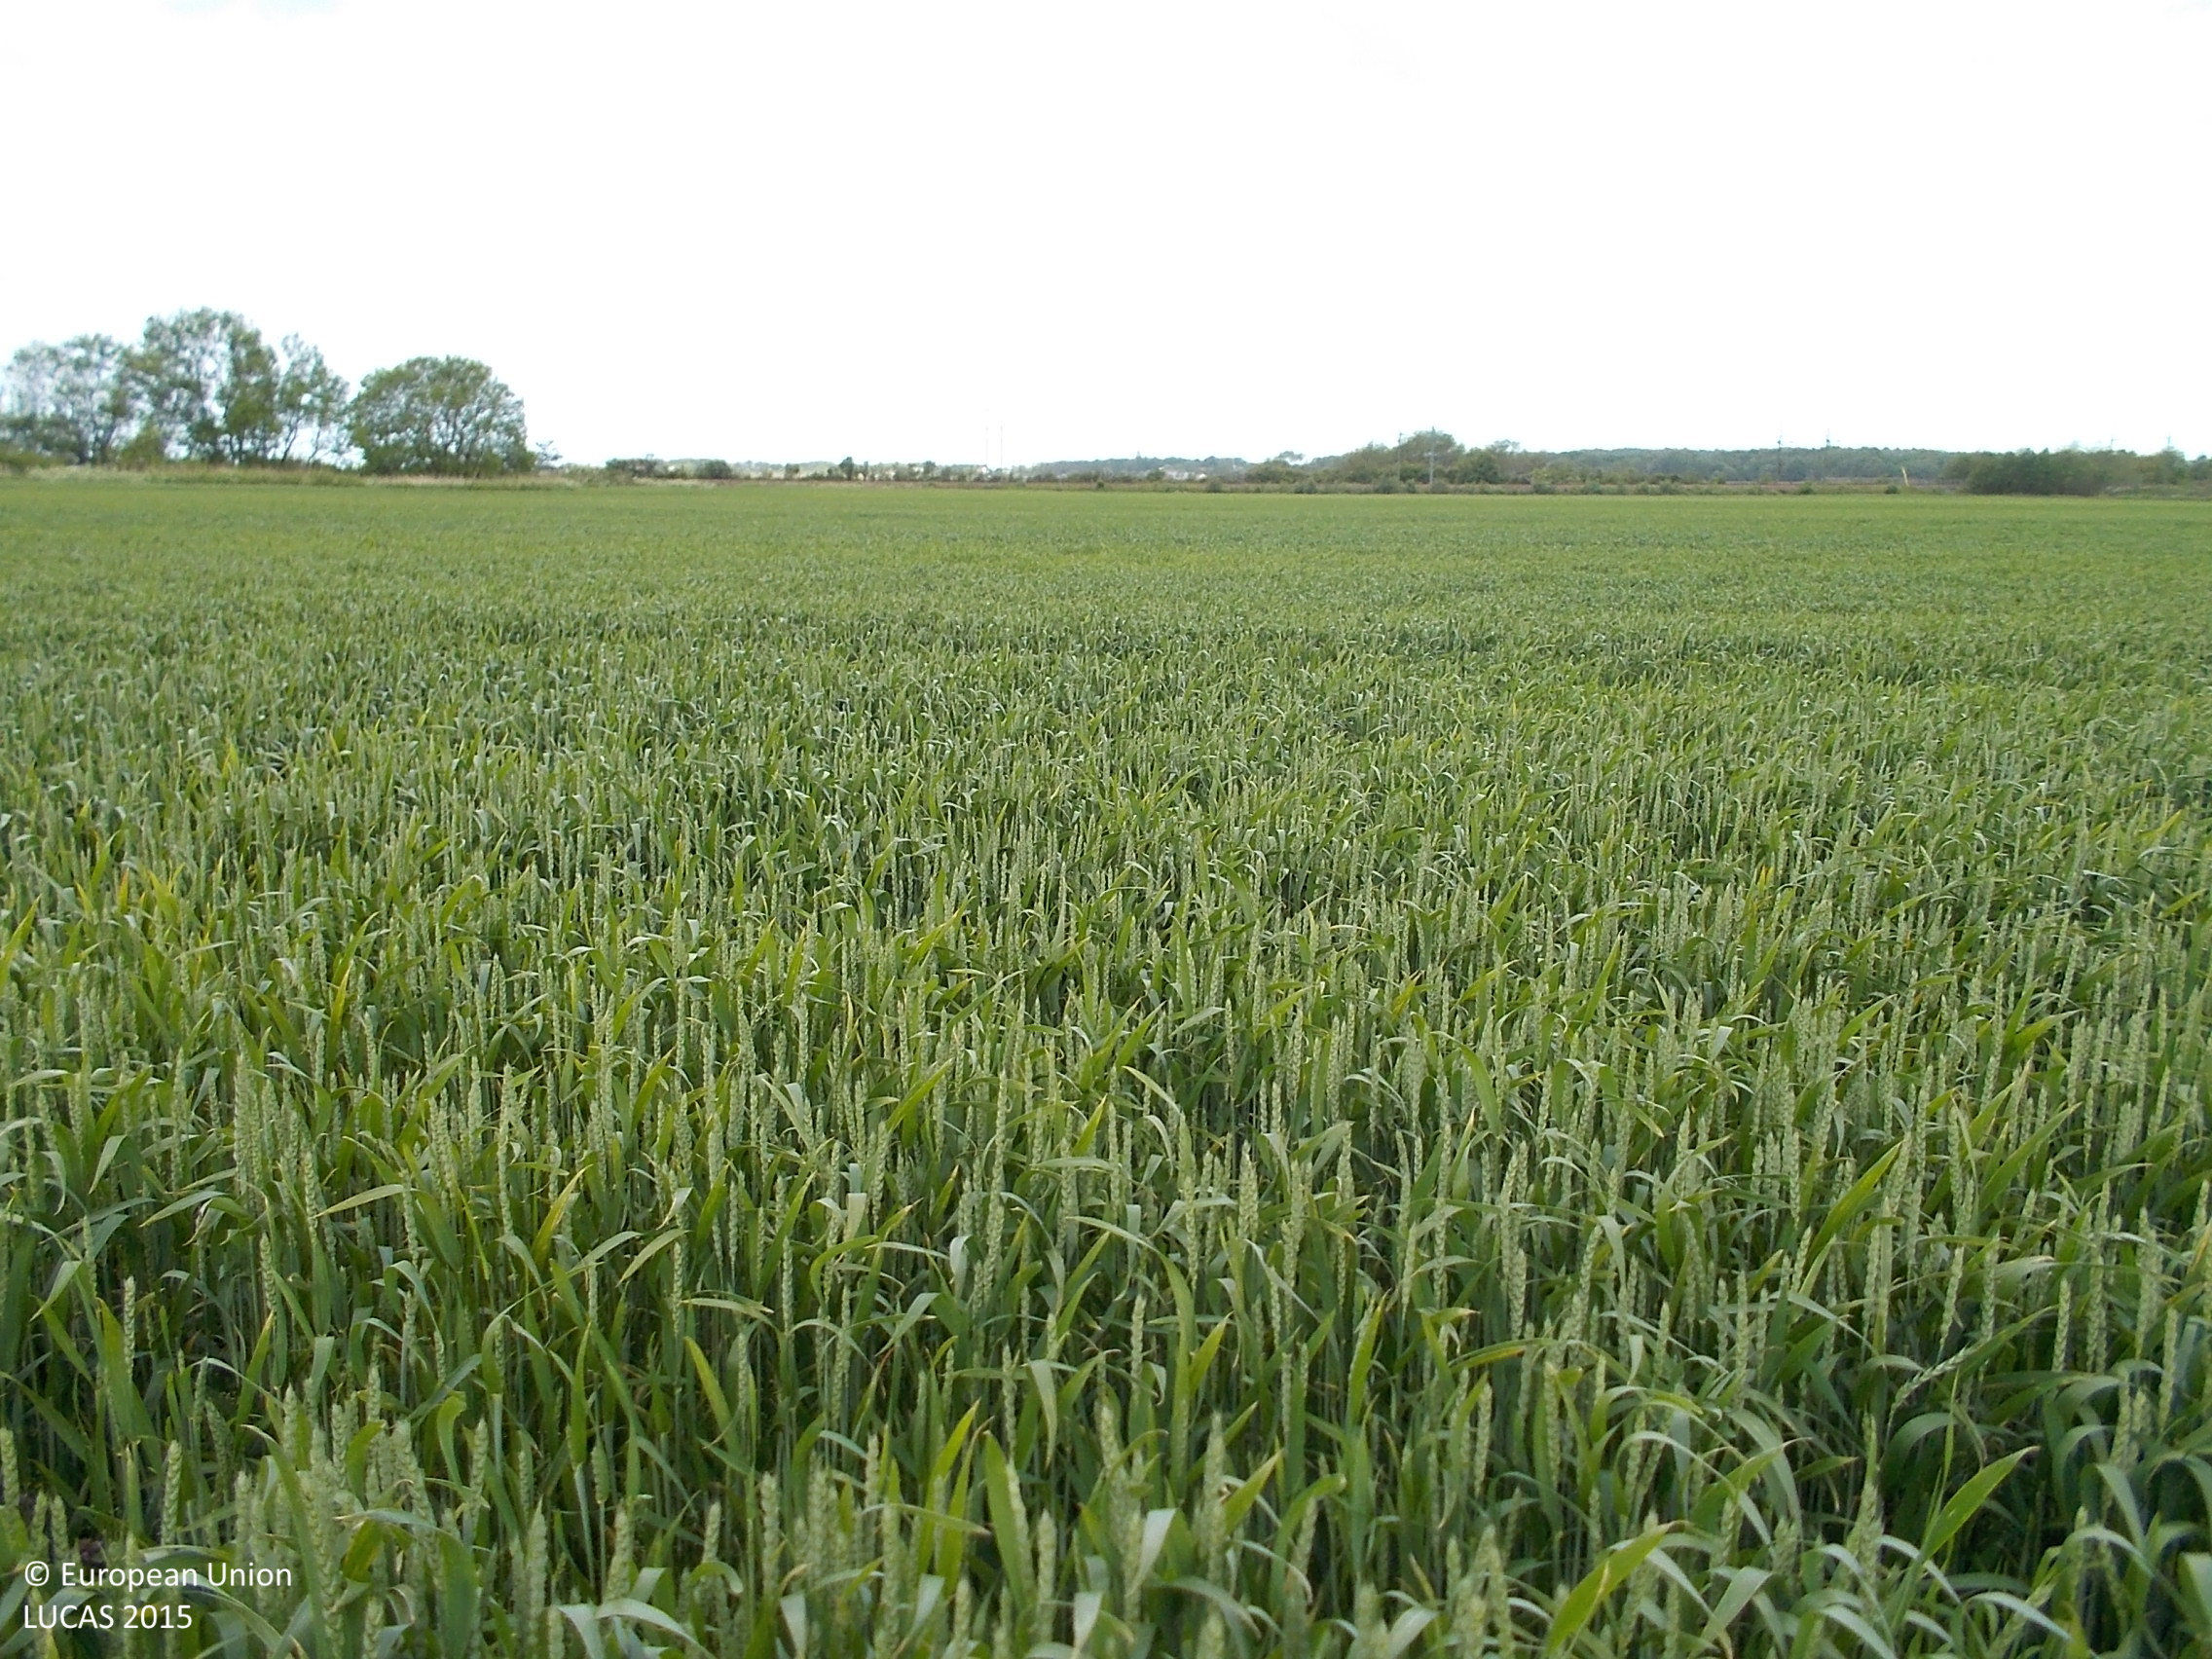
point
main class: Cropland
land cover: Common wheat
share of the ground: > 75 %
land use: Agriculture (excluding fallow land and kitchen gardens)
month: June
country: SE
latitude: 57.1391
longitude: 12.2607
